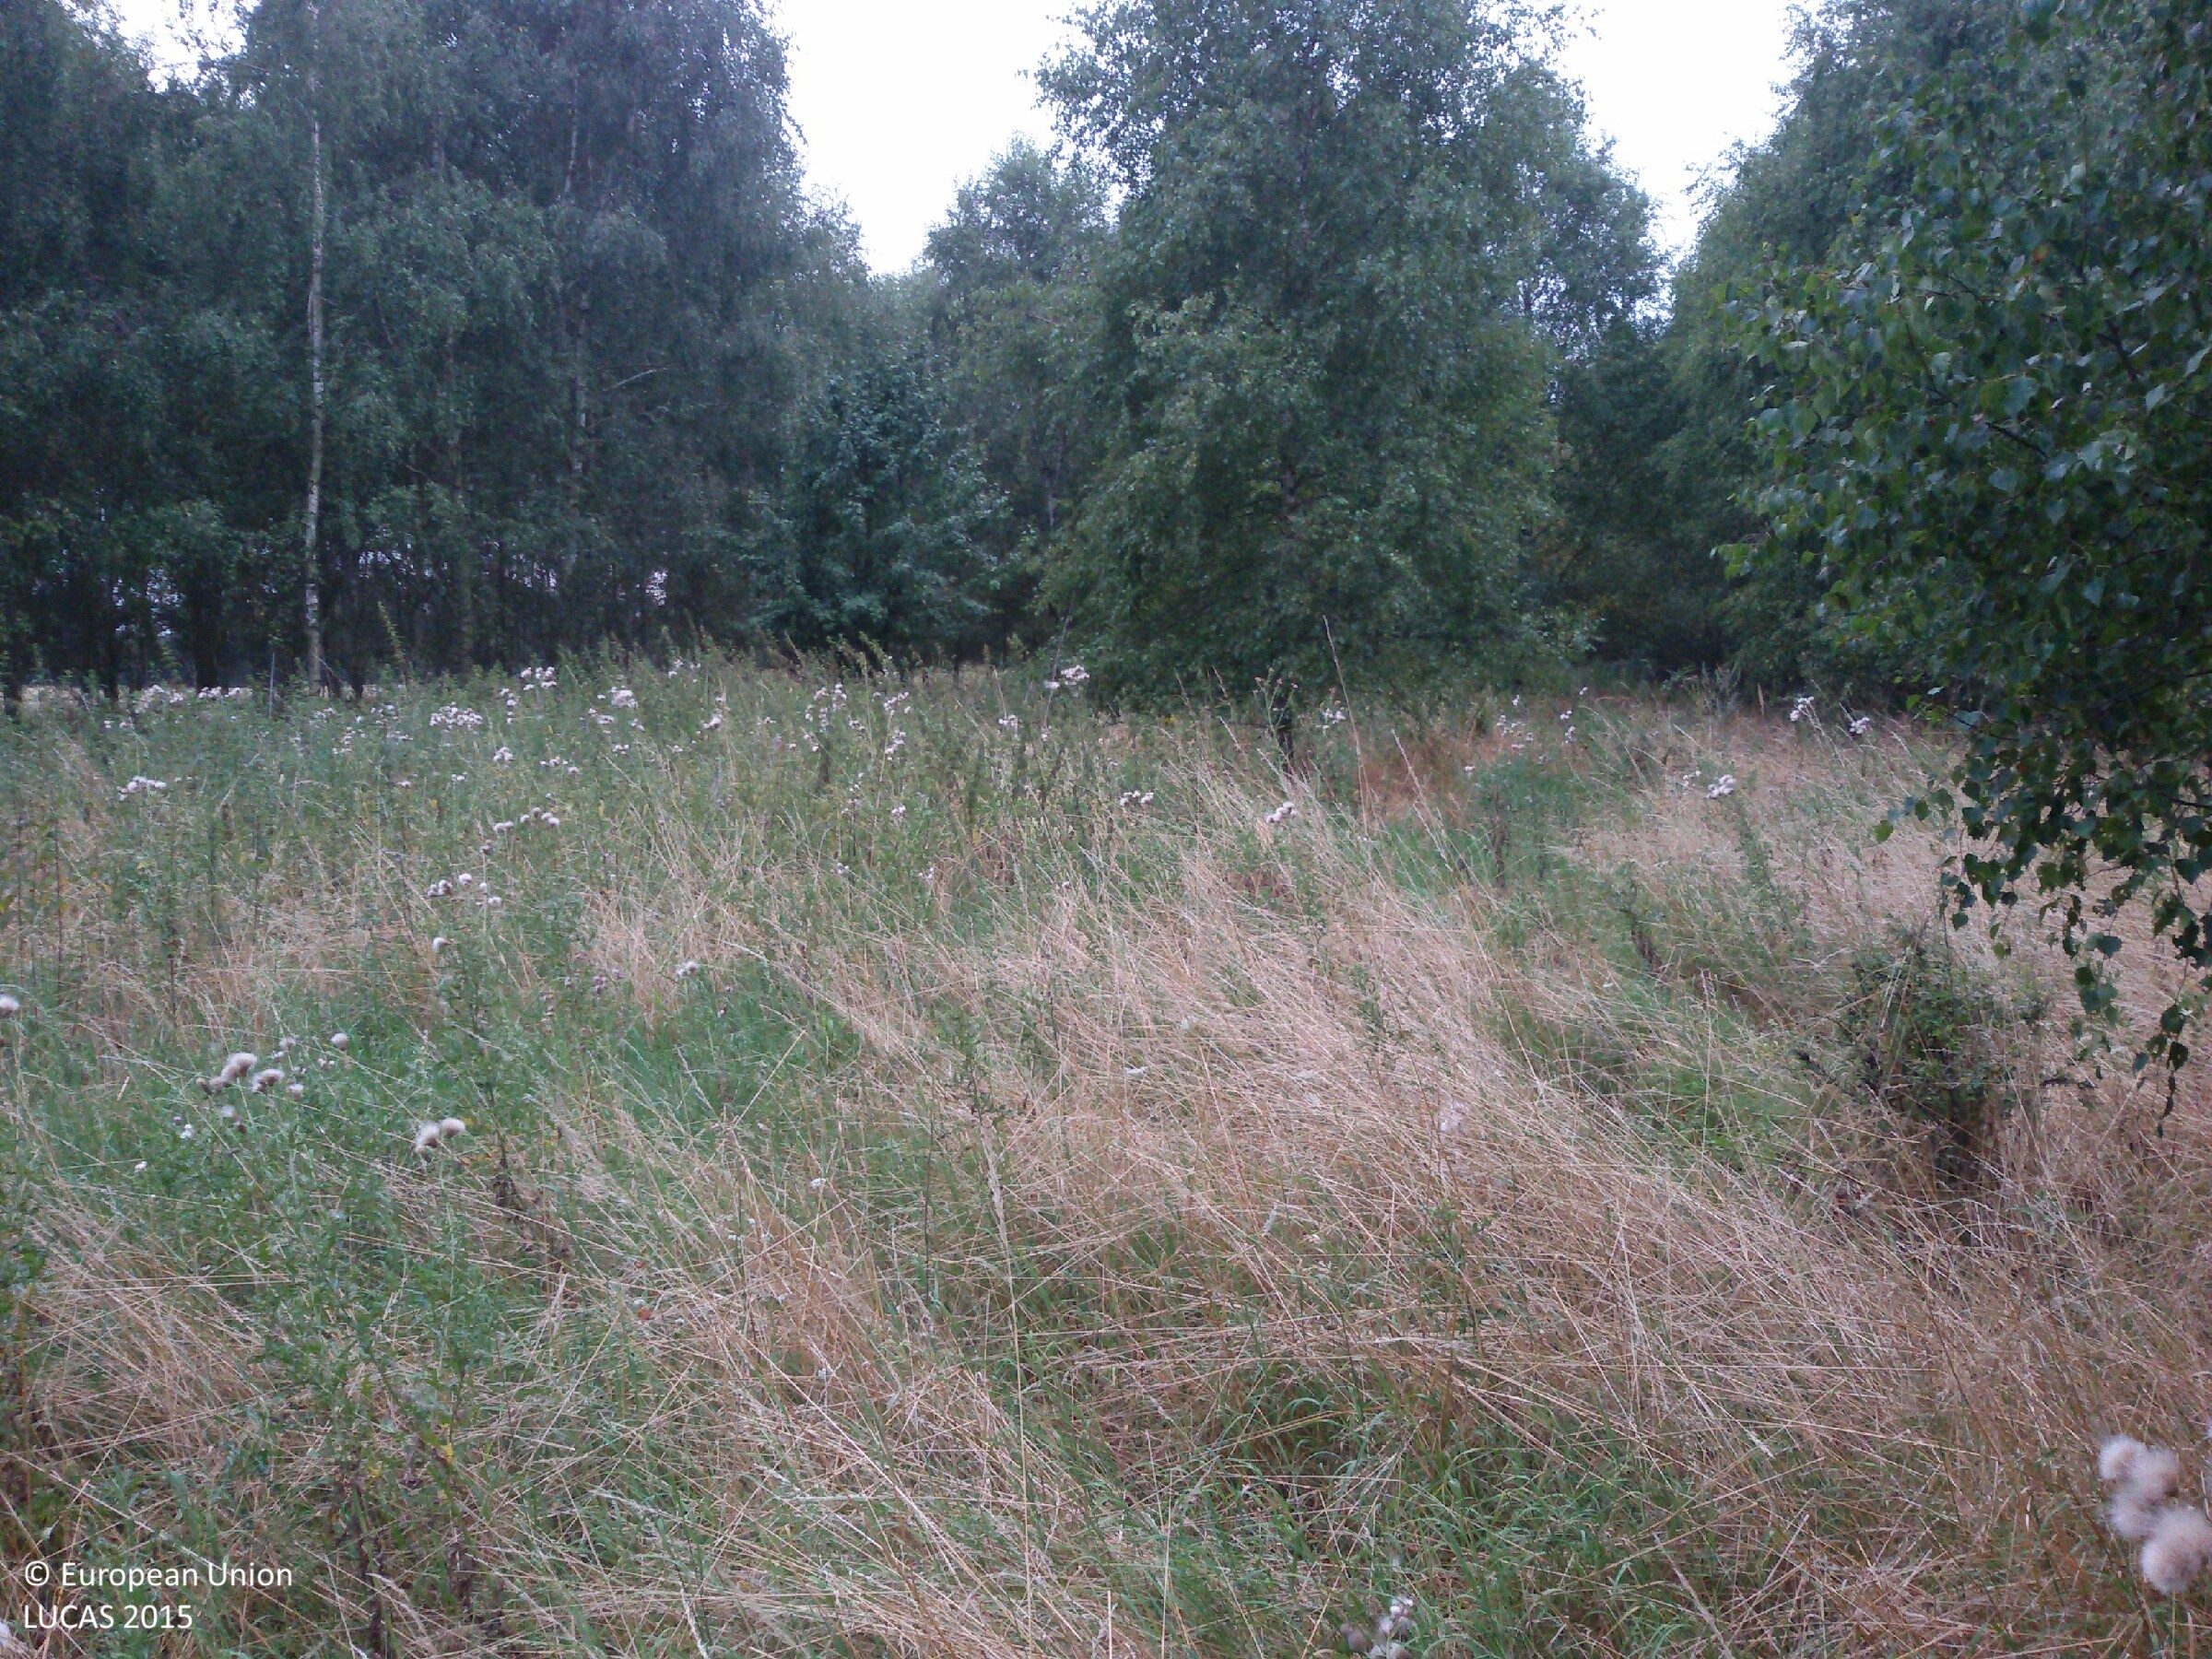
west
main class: Woodland
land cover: Broadleaved woodland
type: mesophytic deciduous forest
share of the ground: 25 - 50 %
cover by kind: herbaceous plants 55 %, broadleaved forest trees 30 %, shrubs 10 %, coniferous forest trees 5 %
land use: Semi-natural and natural areas not in use
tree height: > 5 m
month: August
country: PL
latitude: 52.9960
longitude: 14.4561
